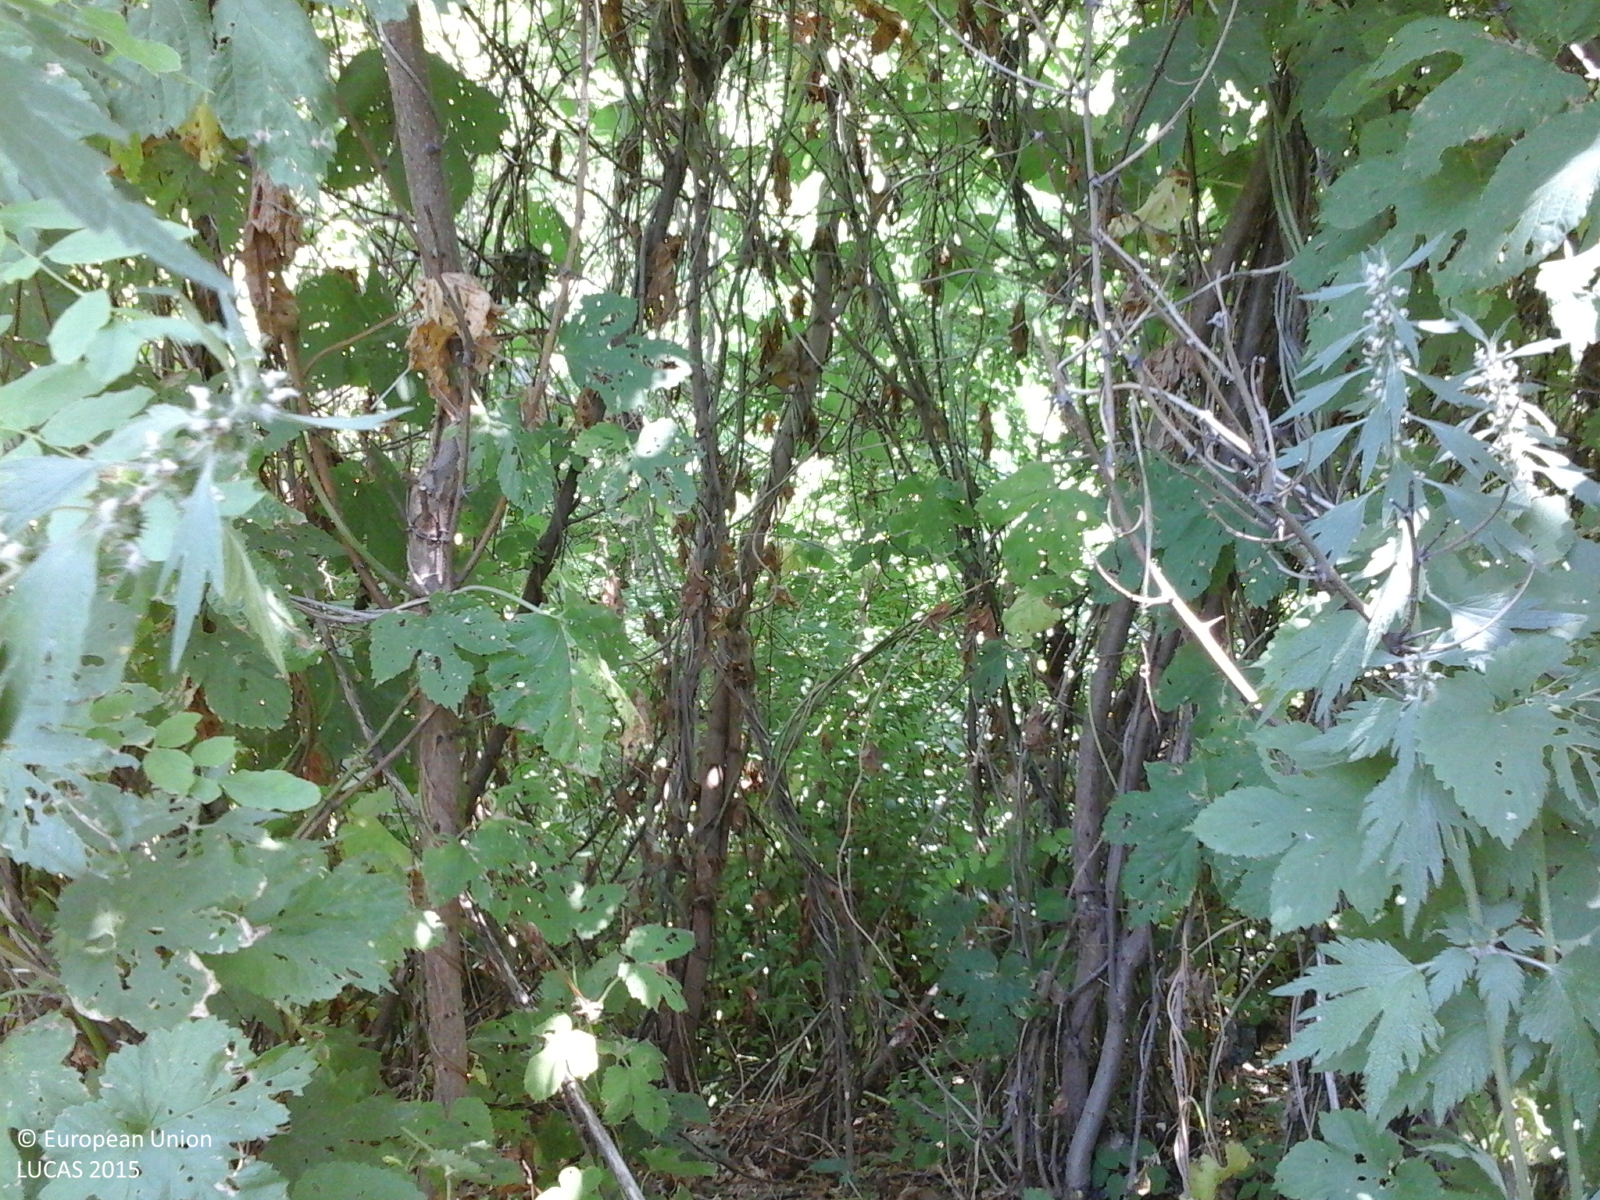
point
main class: Woodland
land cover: Broadleaved woodland
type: beech forest
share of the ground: > 75 %
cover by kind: broadleaved forest trees 100 %
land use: Forestry
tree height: > 5 m
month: June
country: RO
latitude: 46.8141
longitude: 28.0191
